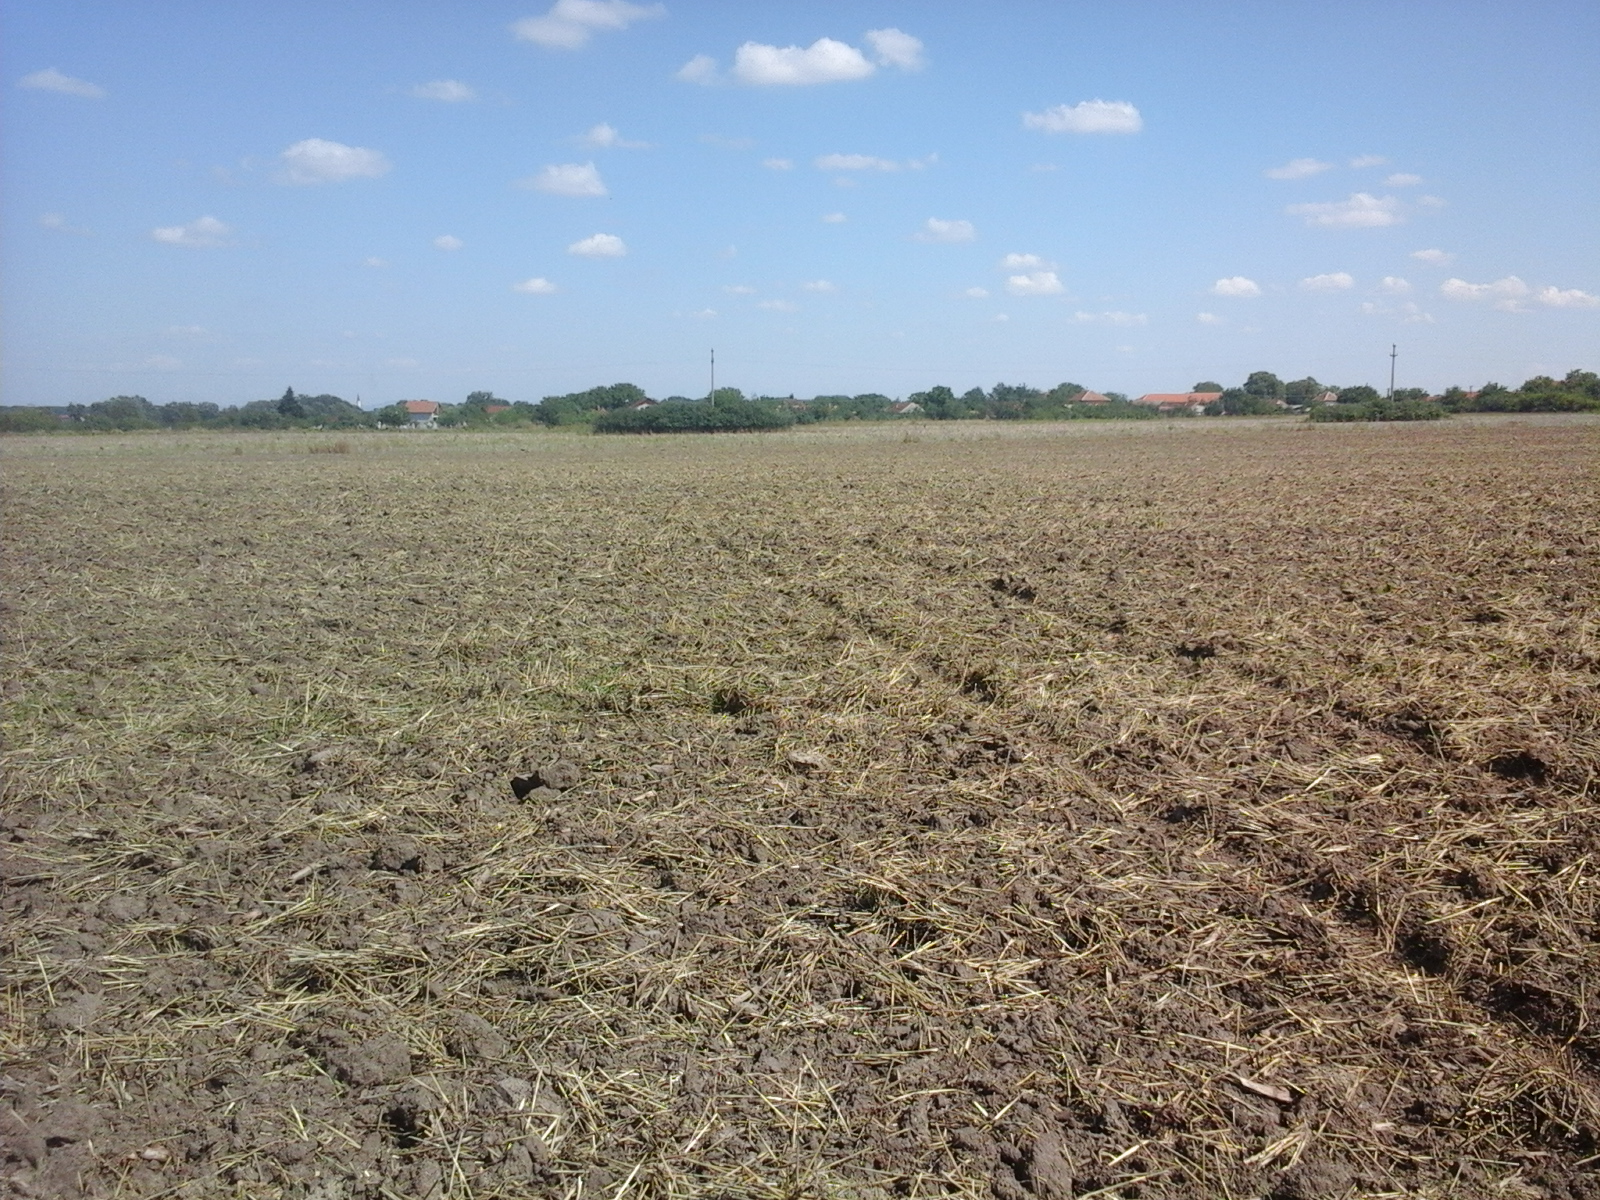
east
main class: Cropland
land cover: Common wheat
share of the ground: < 10 %
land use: Agriculture (excluding fallow land and kitchen gardens)
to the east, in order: Common wheat; Rape and turnip rape; Electric lines; Rape and turnip rape
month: August
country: RO
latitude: 46.1272
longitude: 21.1751
